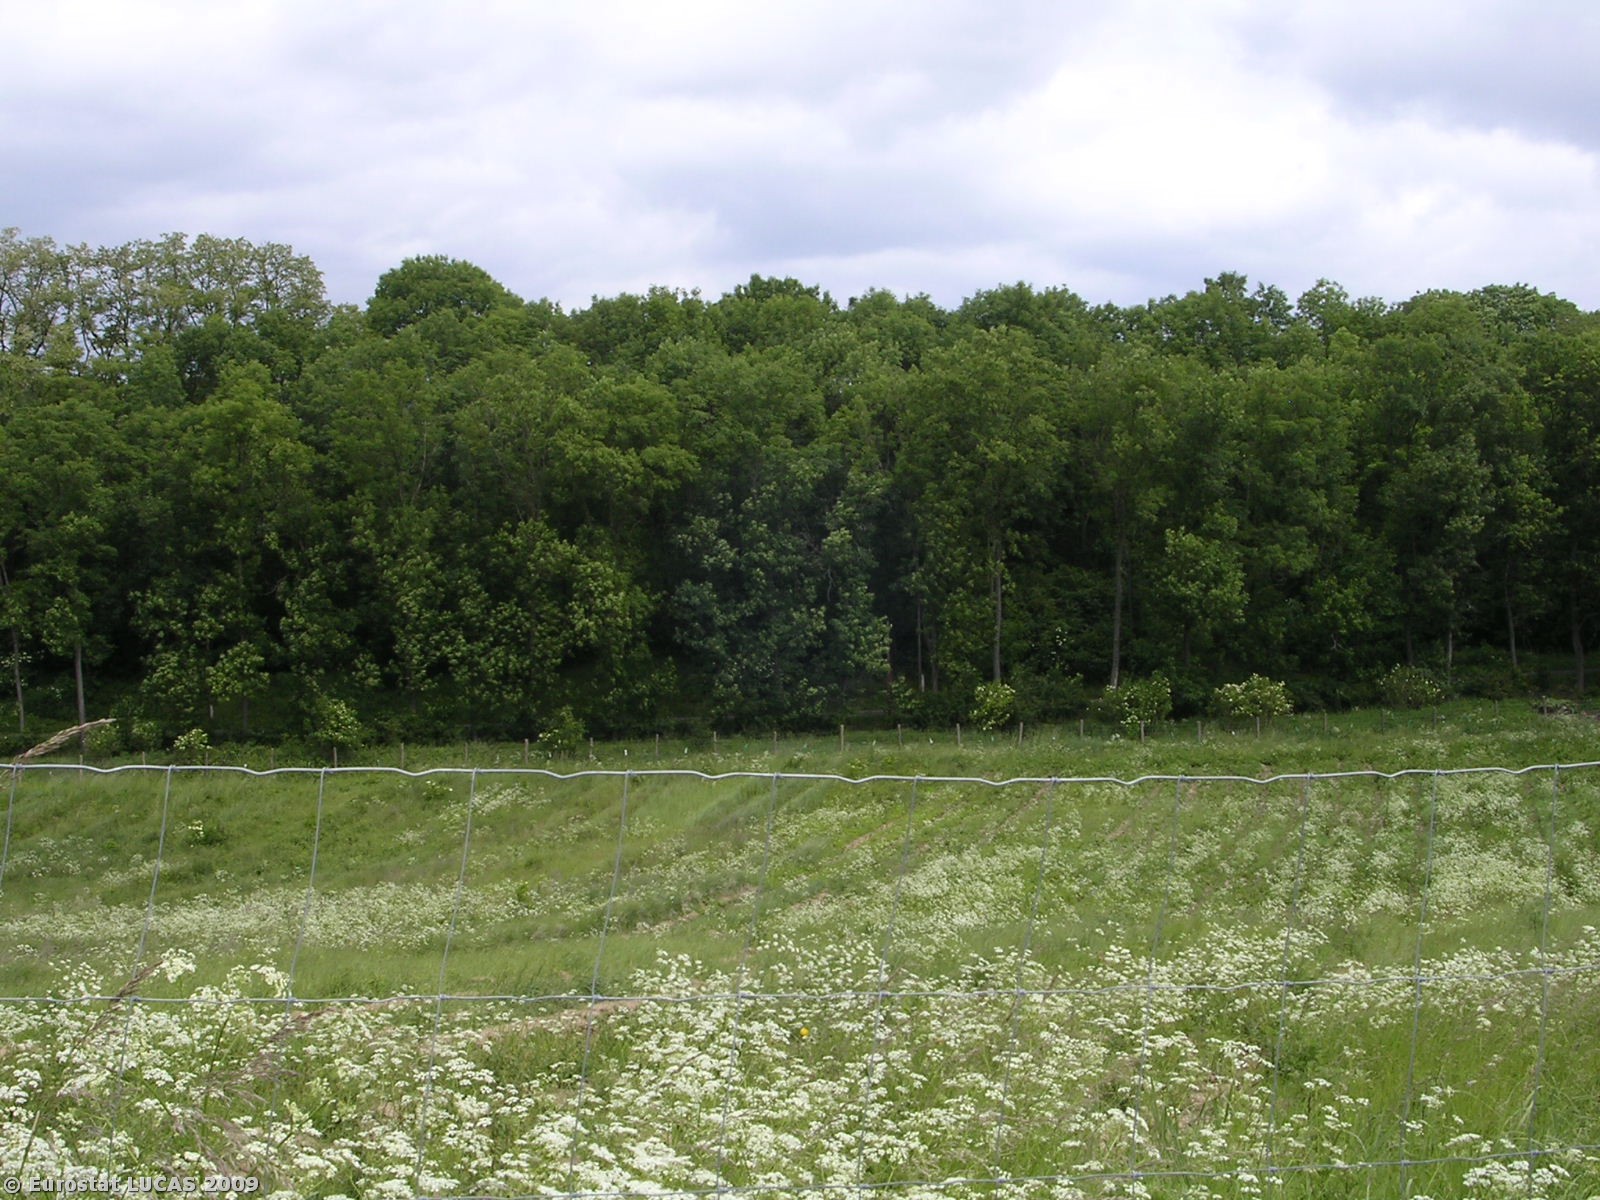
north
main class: Grassland
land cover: Grassland with sparse tree/shrub cover
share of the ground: > 75 %
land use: Fallow land
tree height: > 5 m
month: June
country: CZ
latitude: 50.3785
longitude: 14.6285
